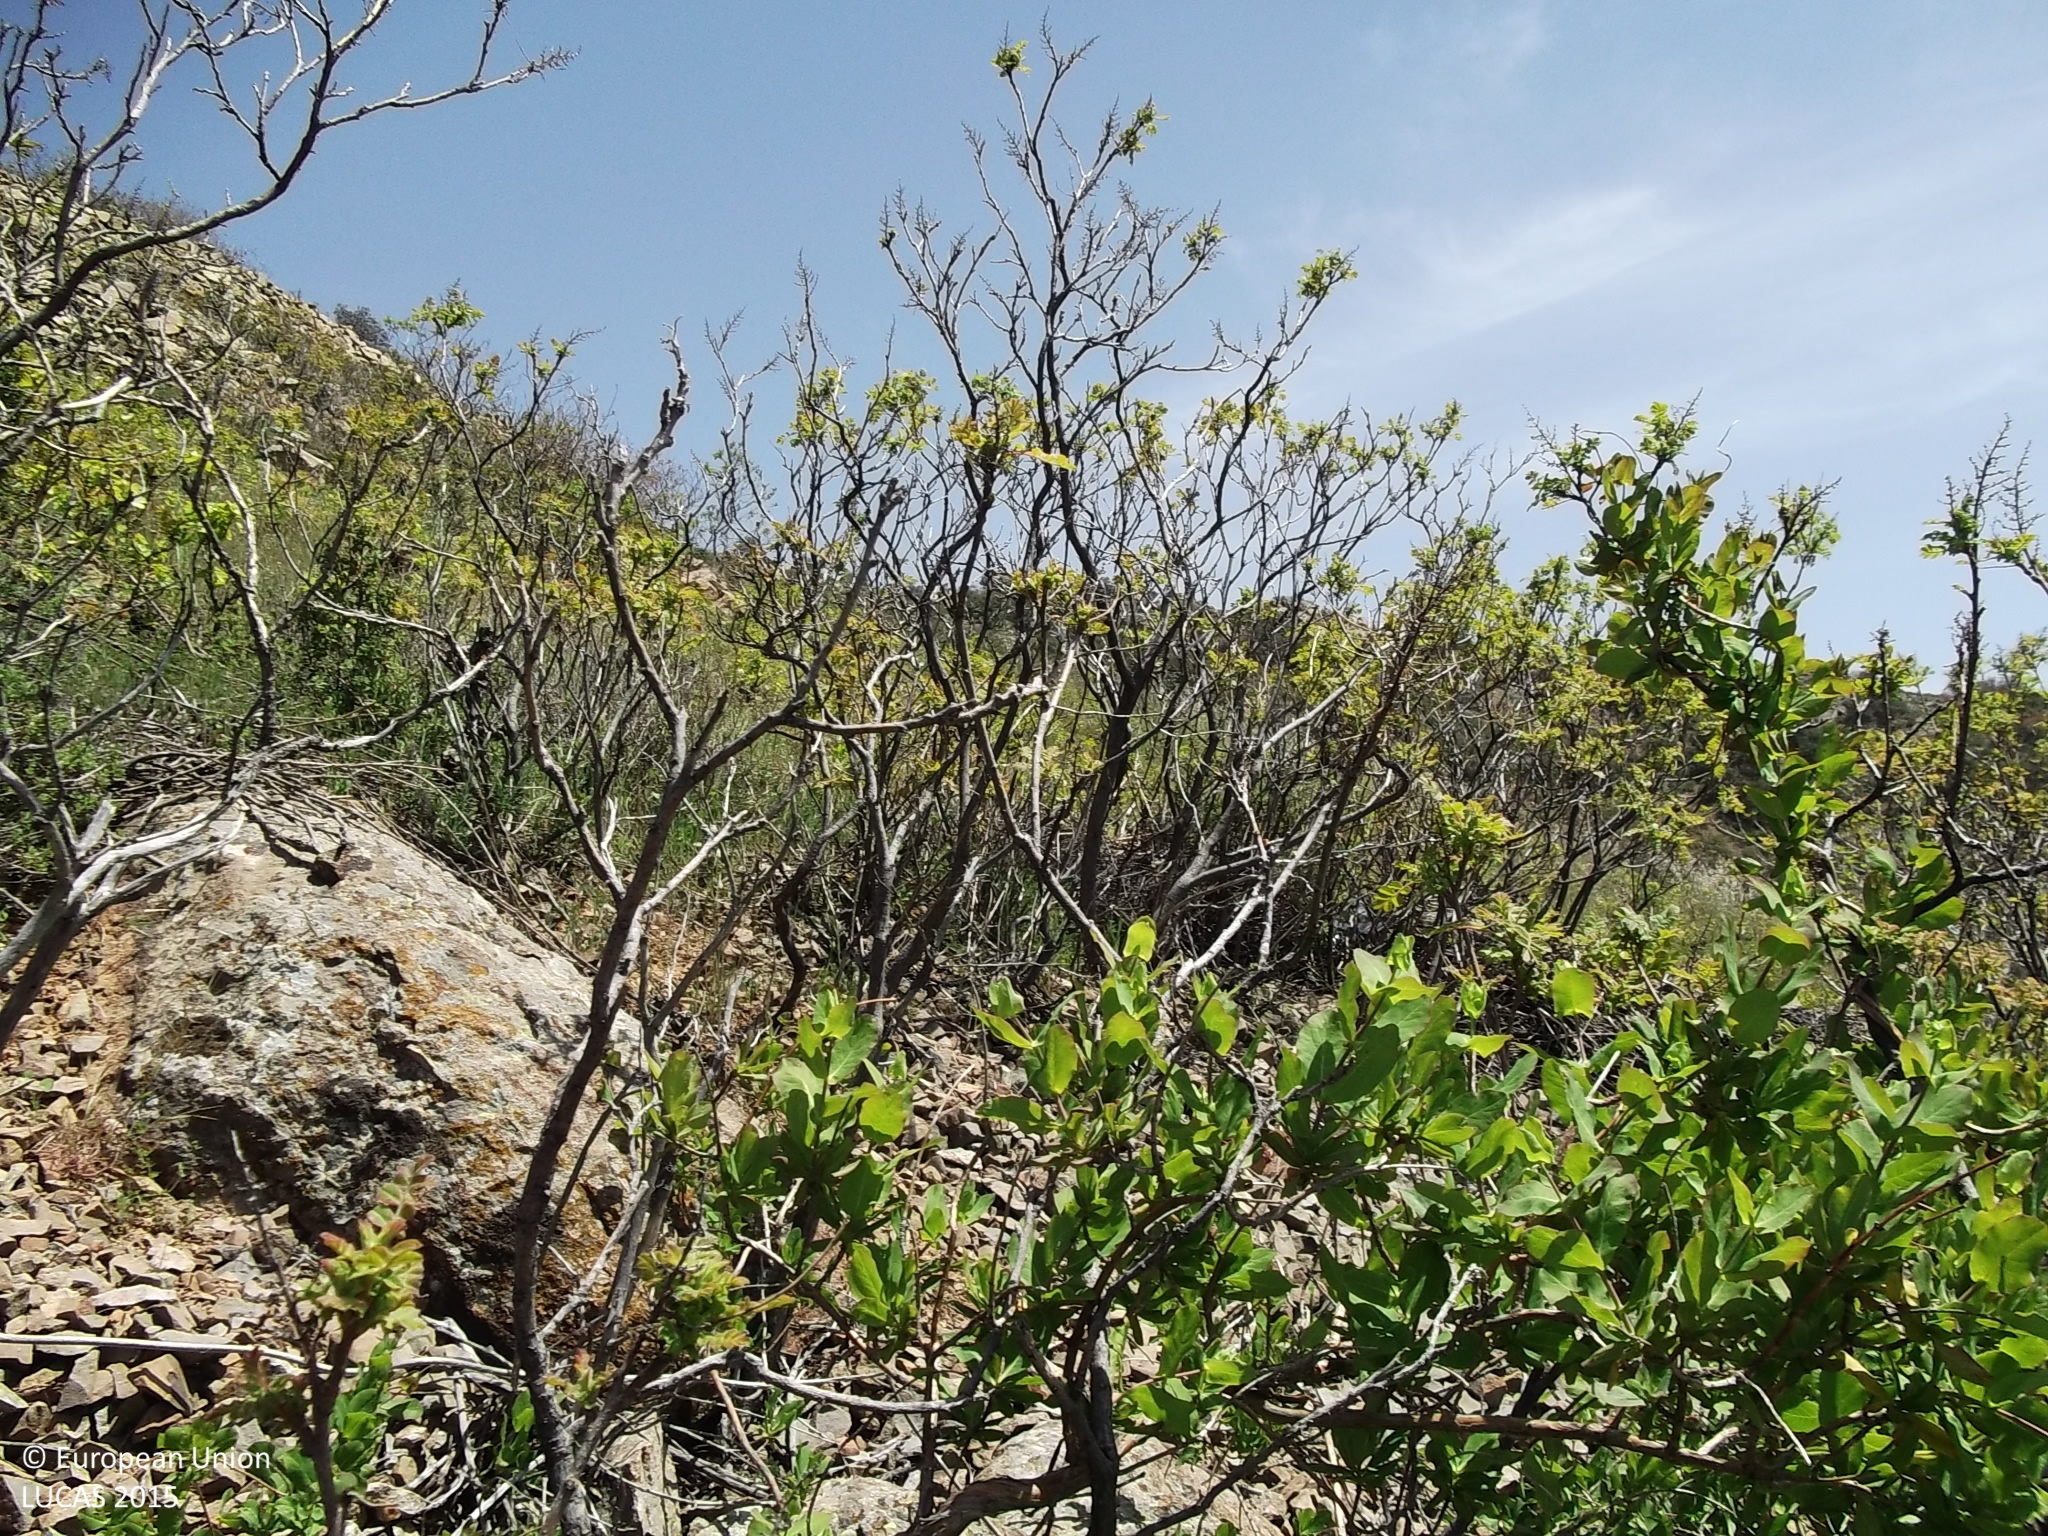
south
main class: Shrubland
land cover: Shrubland without tree cover
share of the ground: > 75 %
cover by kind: shrubs 75 %, consolidated bare surface 15 %, unconsolidated bare surface 10 %
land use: Semi-natural and natural areas not in use
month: April
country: CY
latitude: 34.8951
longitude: 33.1906
